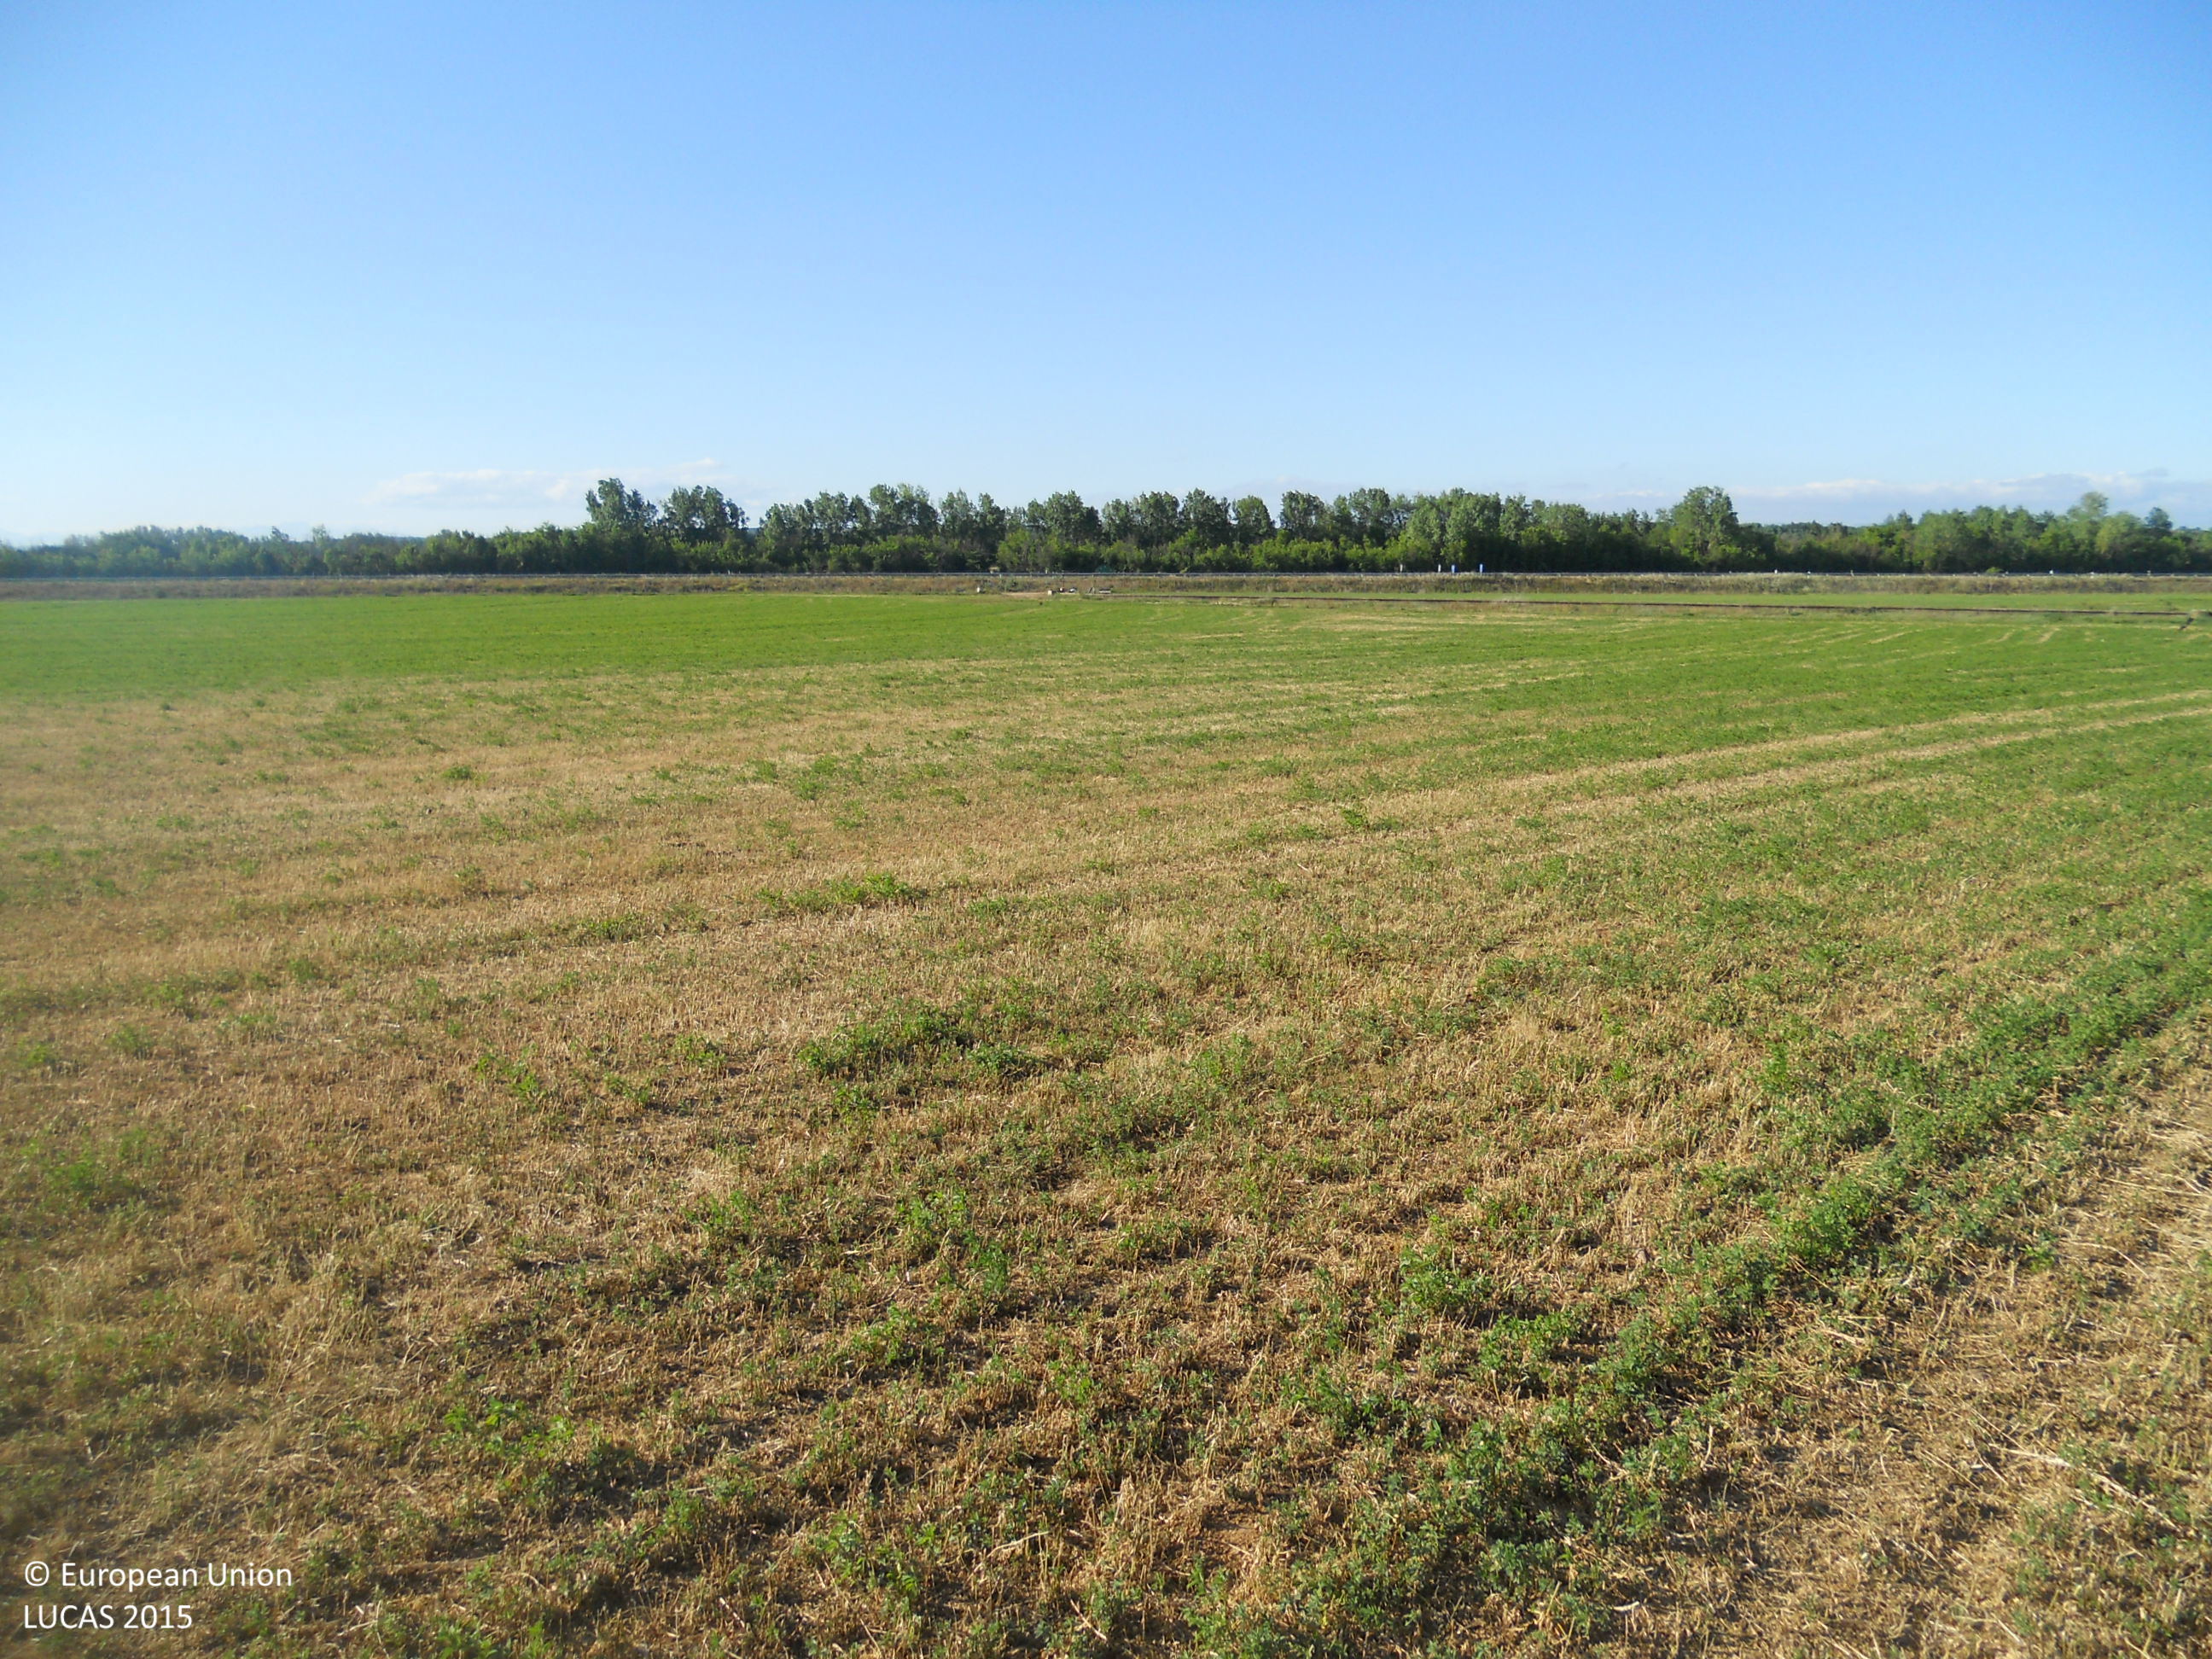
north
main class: Cropland
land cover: Lucerne
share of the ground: > 75 %
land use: Agriculture (excluding fallow land and kitchen gardens)
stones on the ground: < 10 %
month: May
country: ES
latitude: 42.3993
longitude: -4.3220
